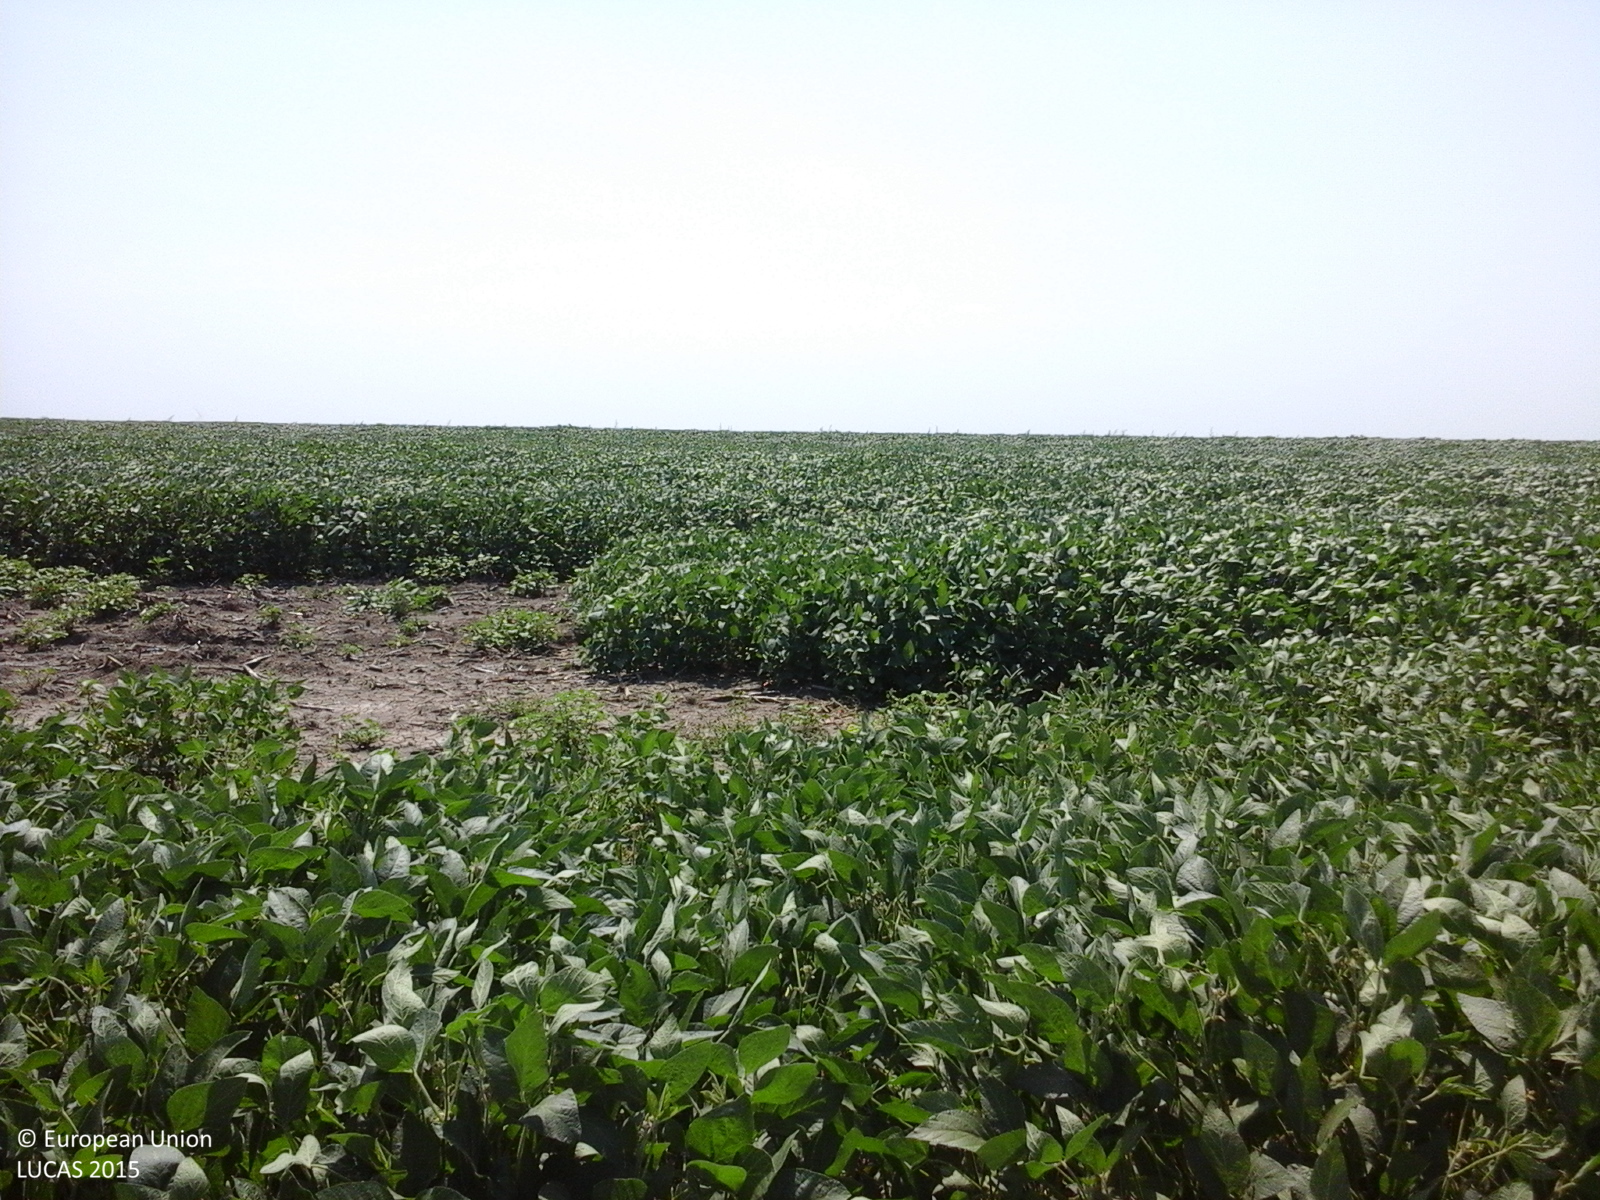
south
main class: Cropland
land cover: Soya
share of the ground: > 75 %
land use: Agriculture (excluding fallow land and kitchen gardens)
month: August
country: RO
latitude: 45.1036
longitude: 27.9950
